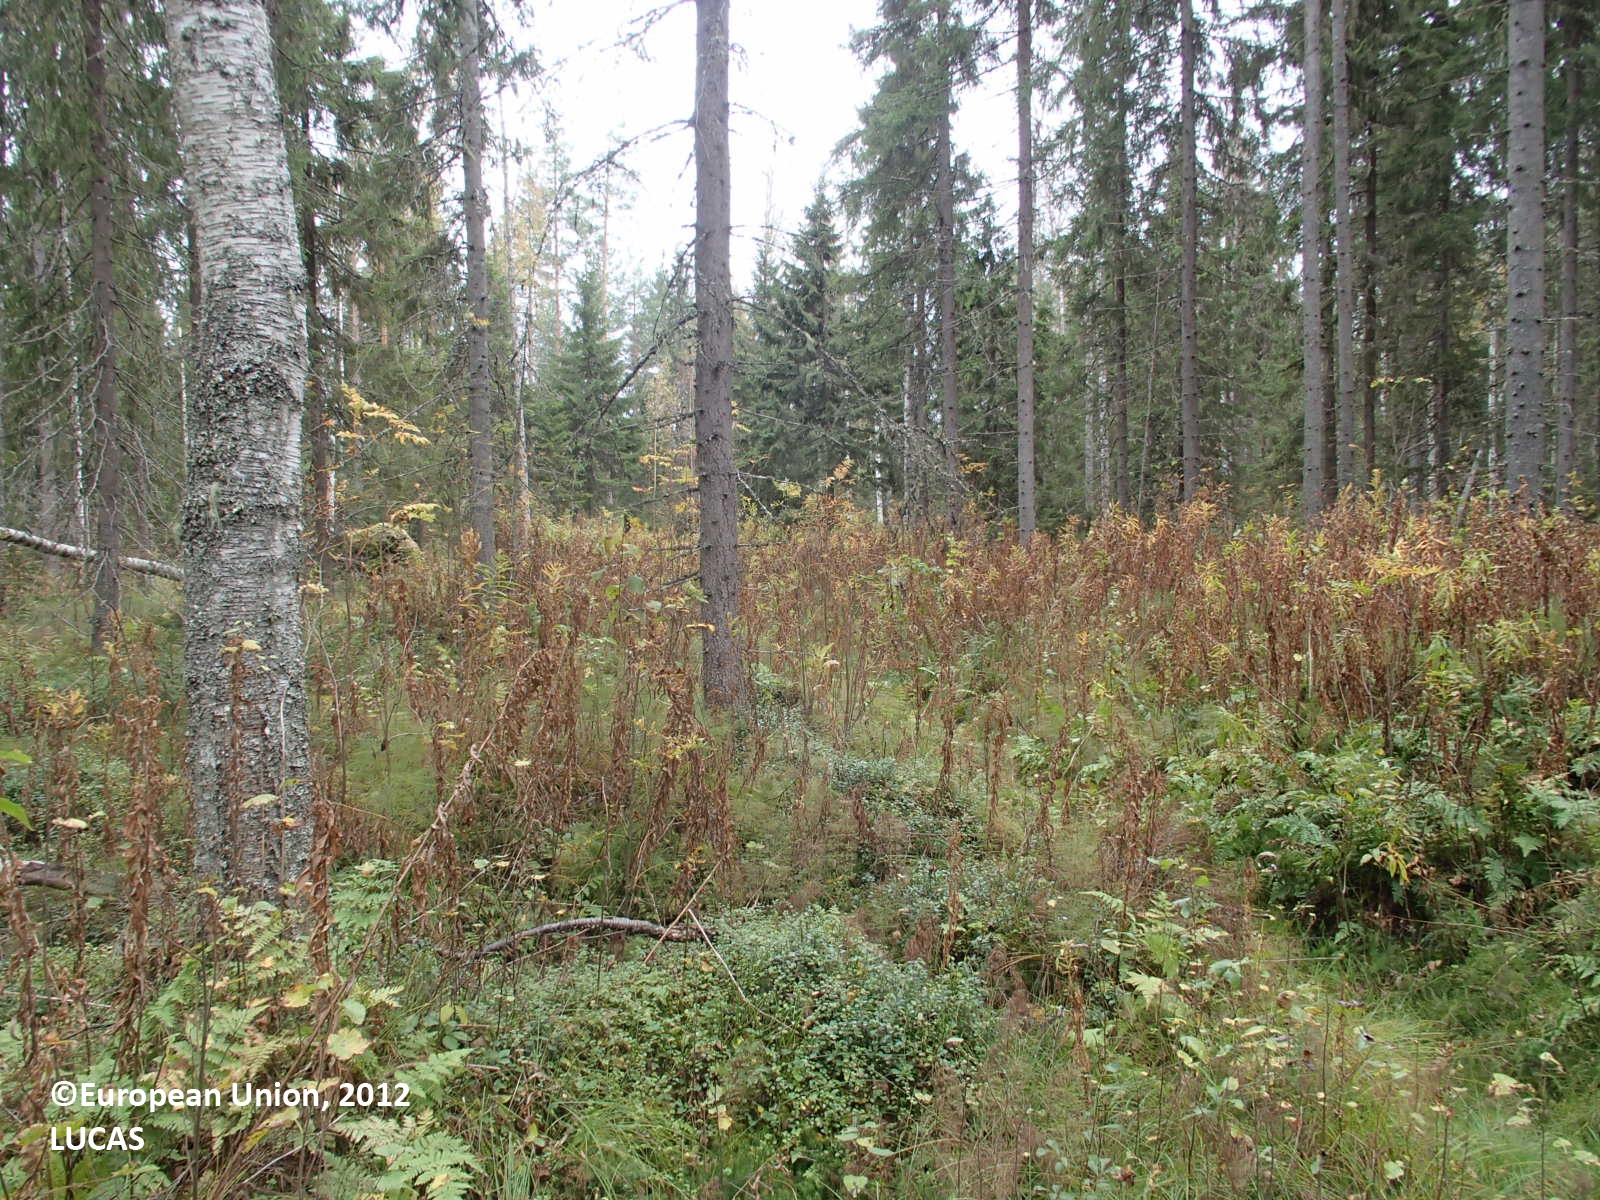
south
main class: Woodland
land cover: Spruce dominated coniferous woodland
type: boreal forest
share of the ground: 50 - 75 %
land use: Forestry
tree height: > 5 m
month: September
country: FI
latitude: 63.5387
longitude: 26.0247
